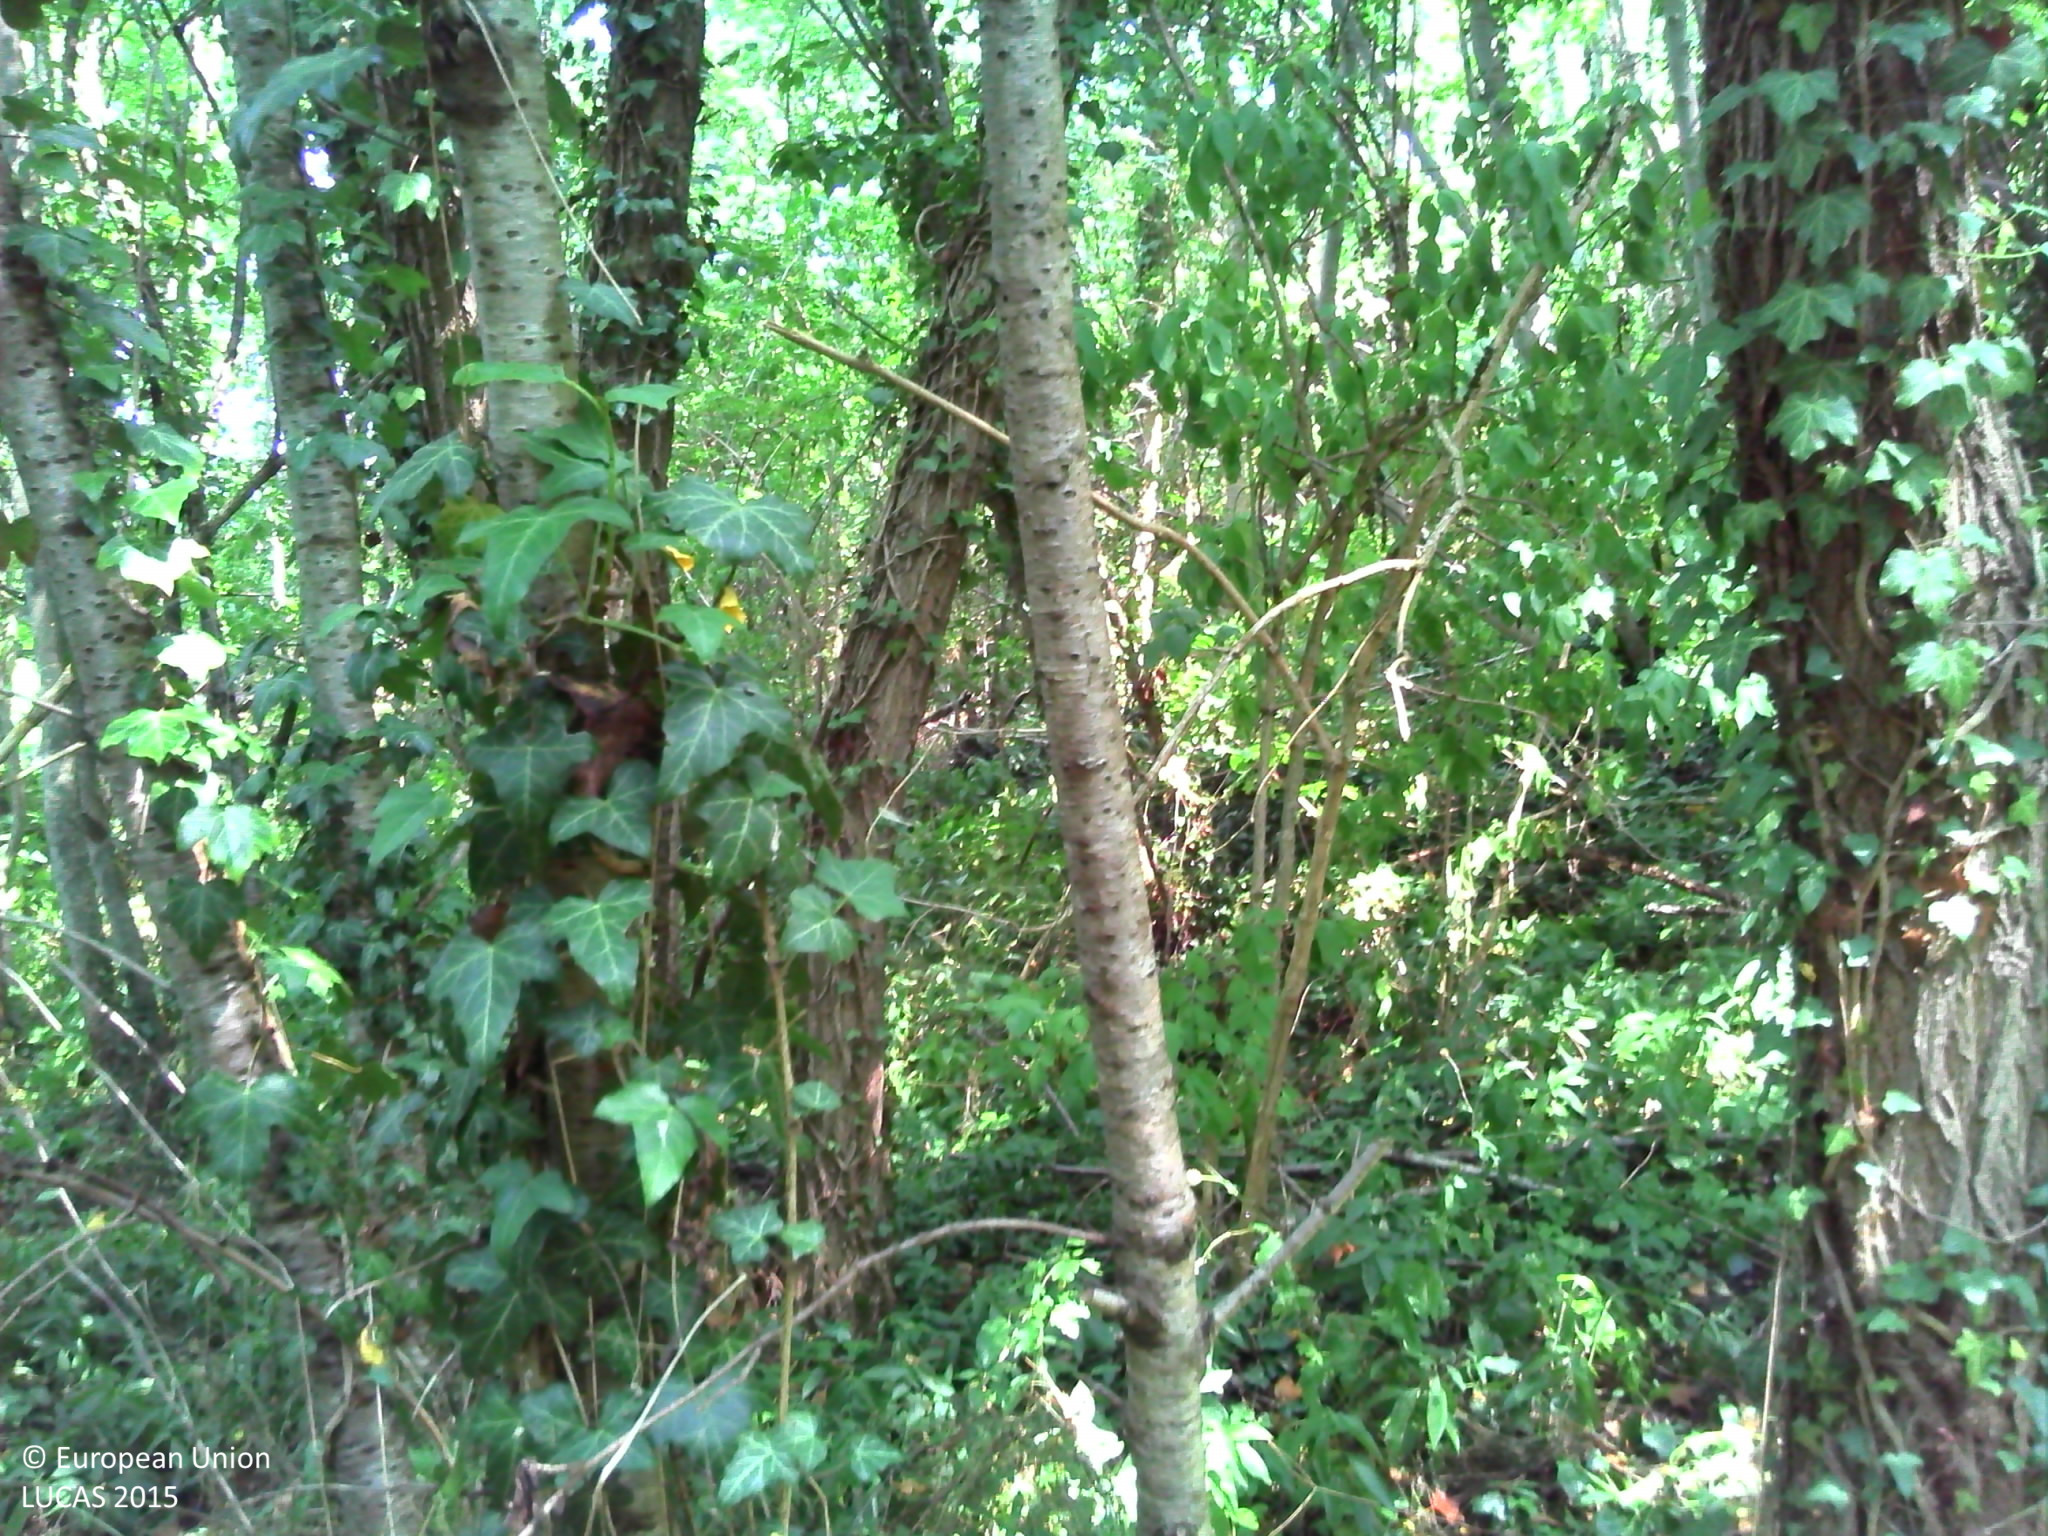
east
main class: Woodland
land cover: Broadleaved woodland
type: beech forest
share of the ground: > 75 %
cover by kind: broadleaved forest trees 50 %, herbaceous plants 40 %, lichens and mosses 10 %
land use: Semi-natural and natural areas not in use
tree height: > 5 m
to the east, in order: Broadleaved woodland
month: July
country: FR
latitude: 45.5333
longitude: 3.1242
